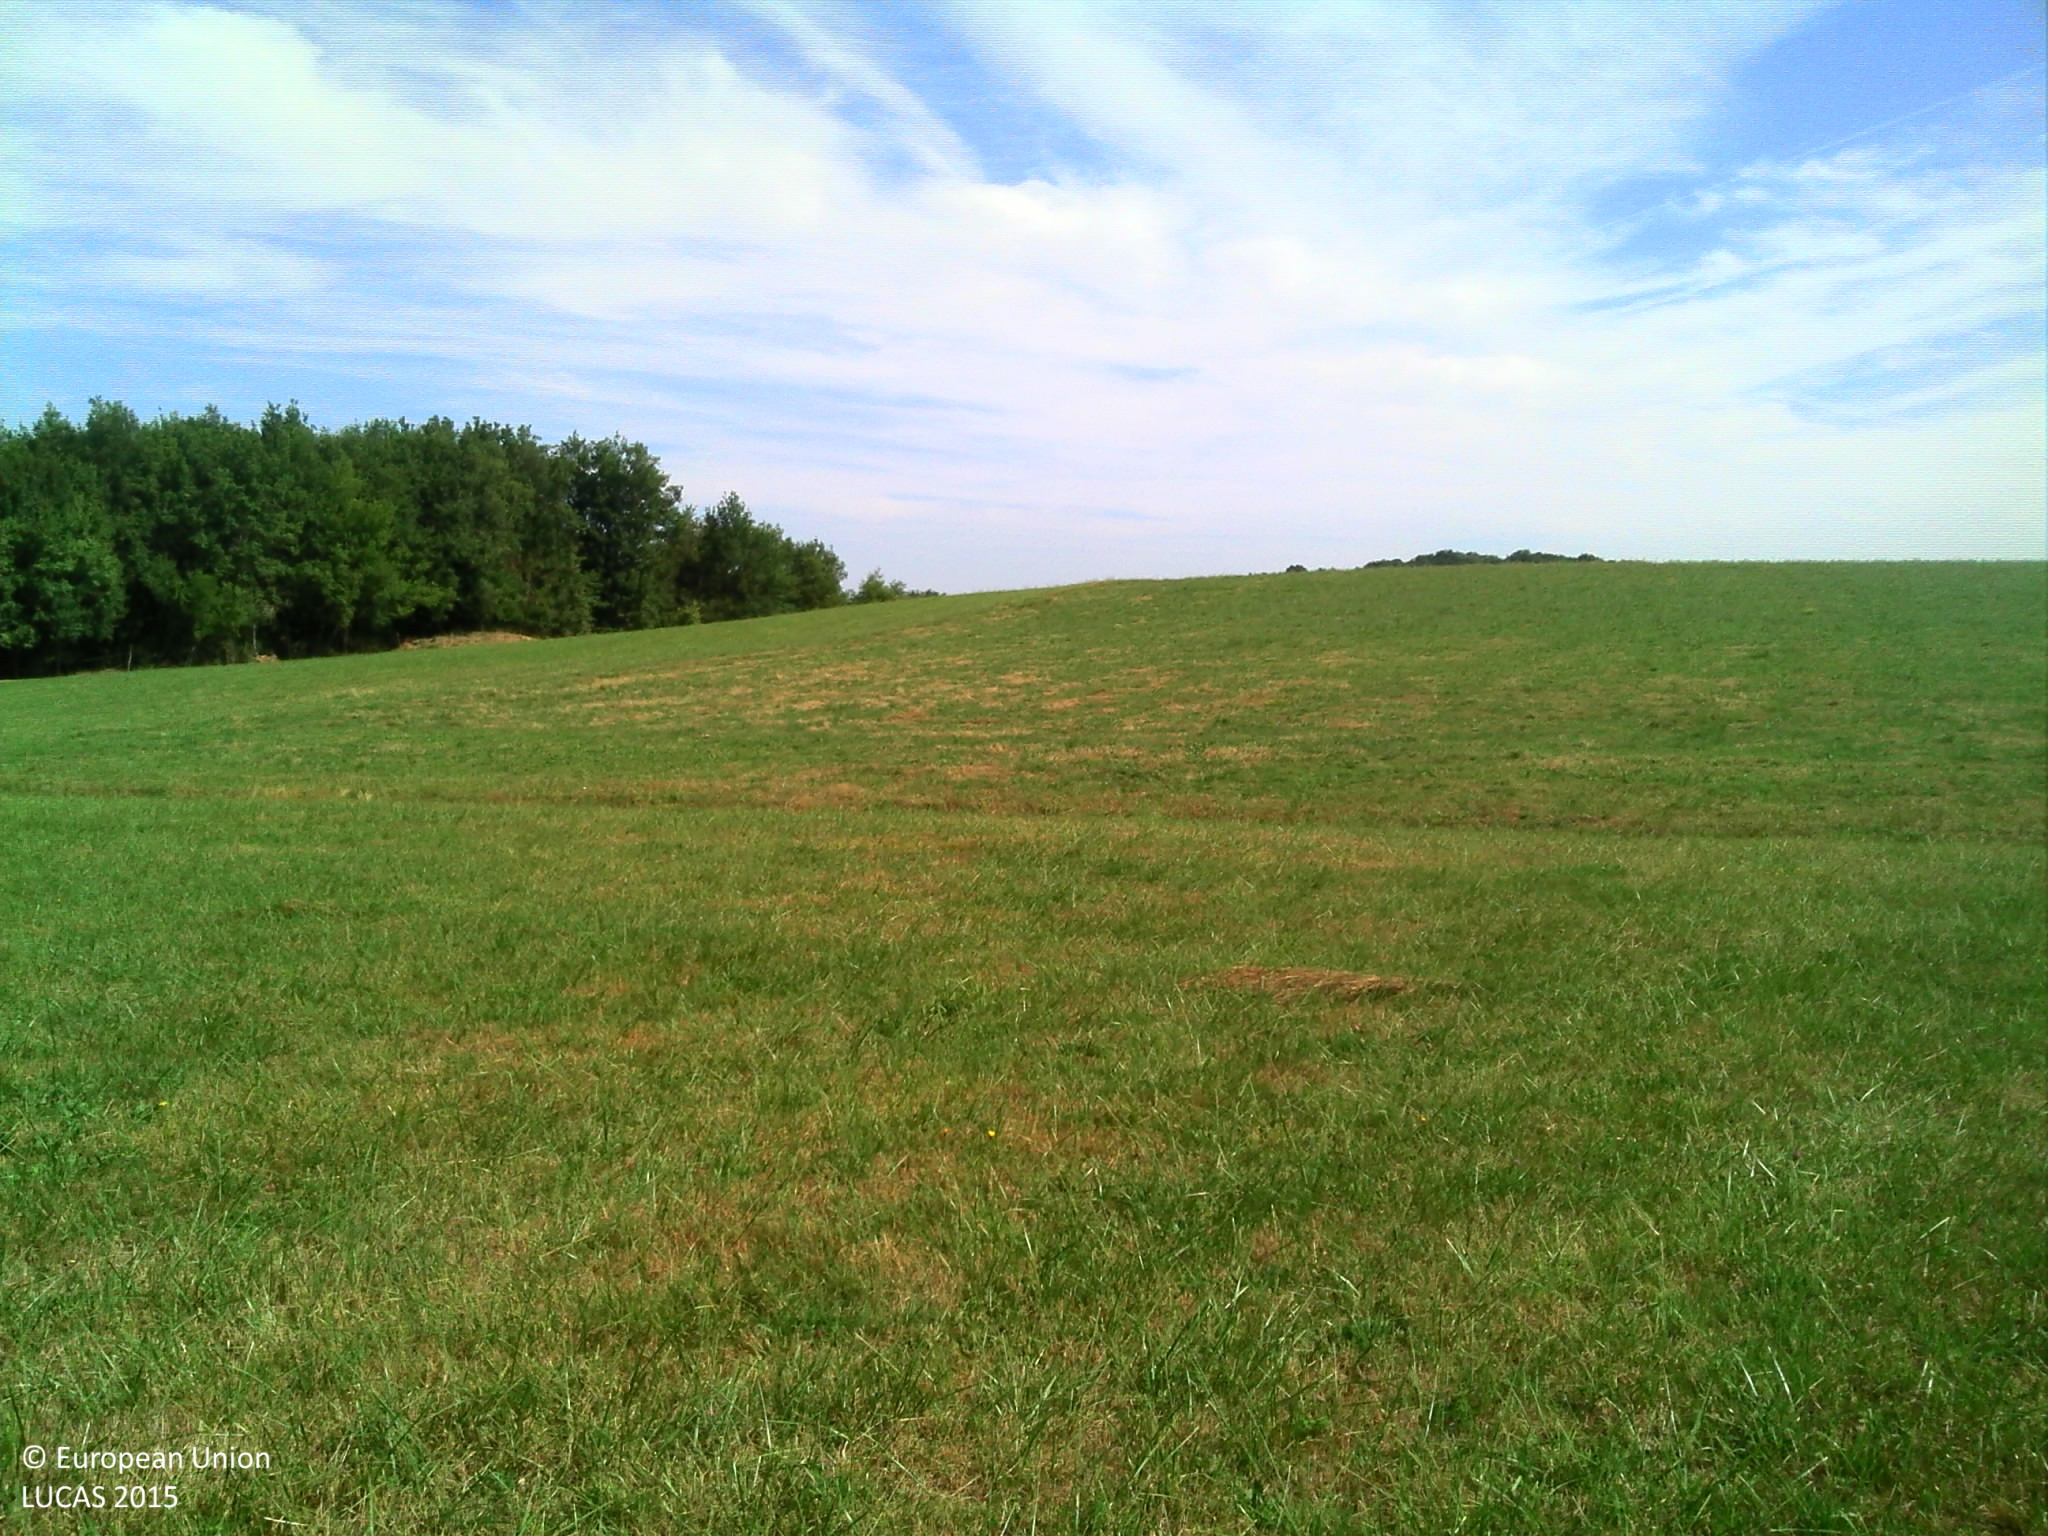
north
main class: Grassland
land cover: Grassland without tree/shrub cover
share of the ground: > 75 %
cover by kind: herbaceous plants 100 %
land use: Agriculture (excluding fallow land and kitchen gardens)
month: July
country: FR
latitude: 43.1658
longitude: 1.0613
